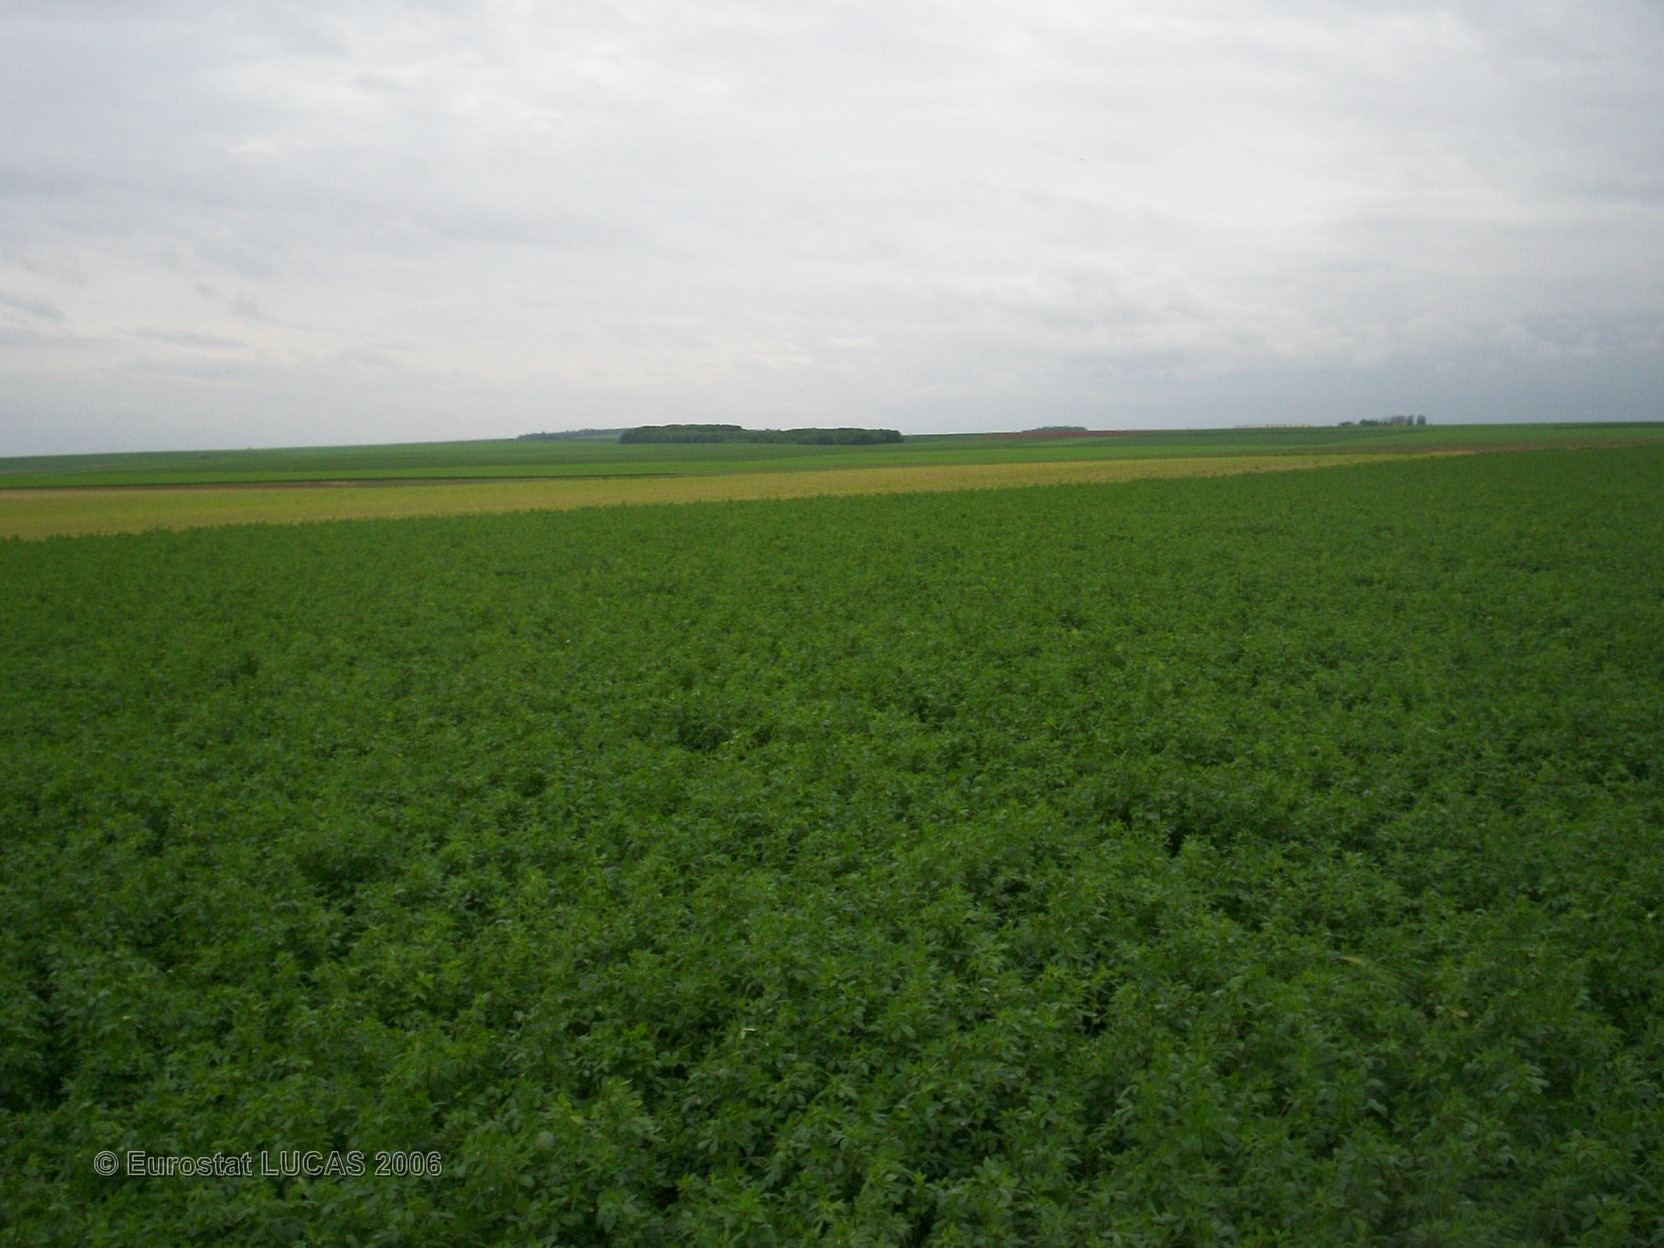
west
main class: Cropland
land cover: Lucerne
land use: Agriculture (excluding fallow land and kitchen gardens)
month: May
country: FR
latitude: 49.3943
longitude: 4.3330
